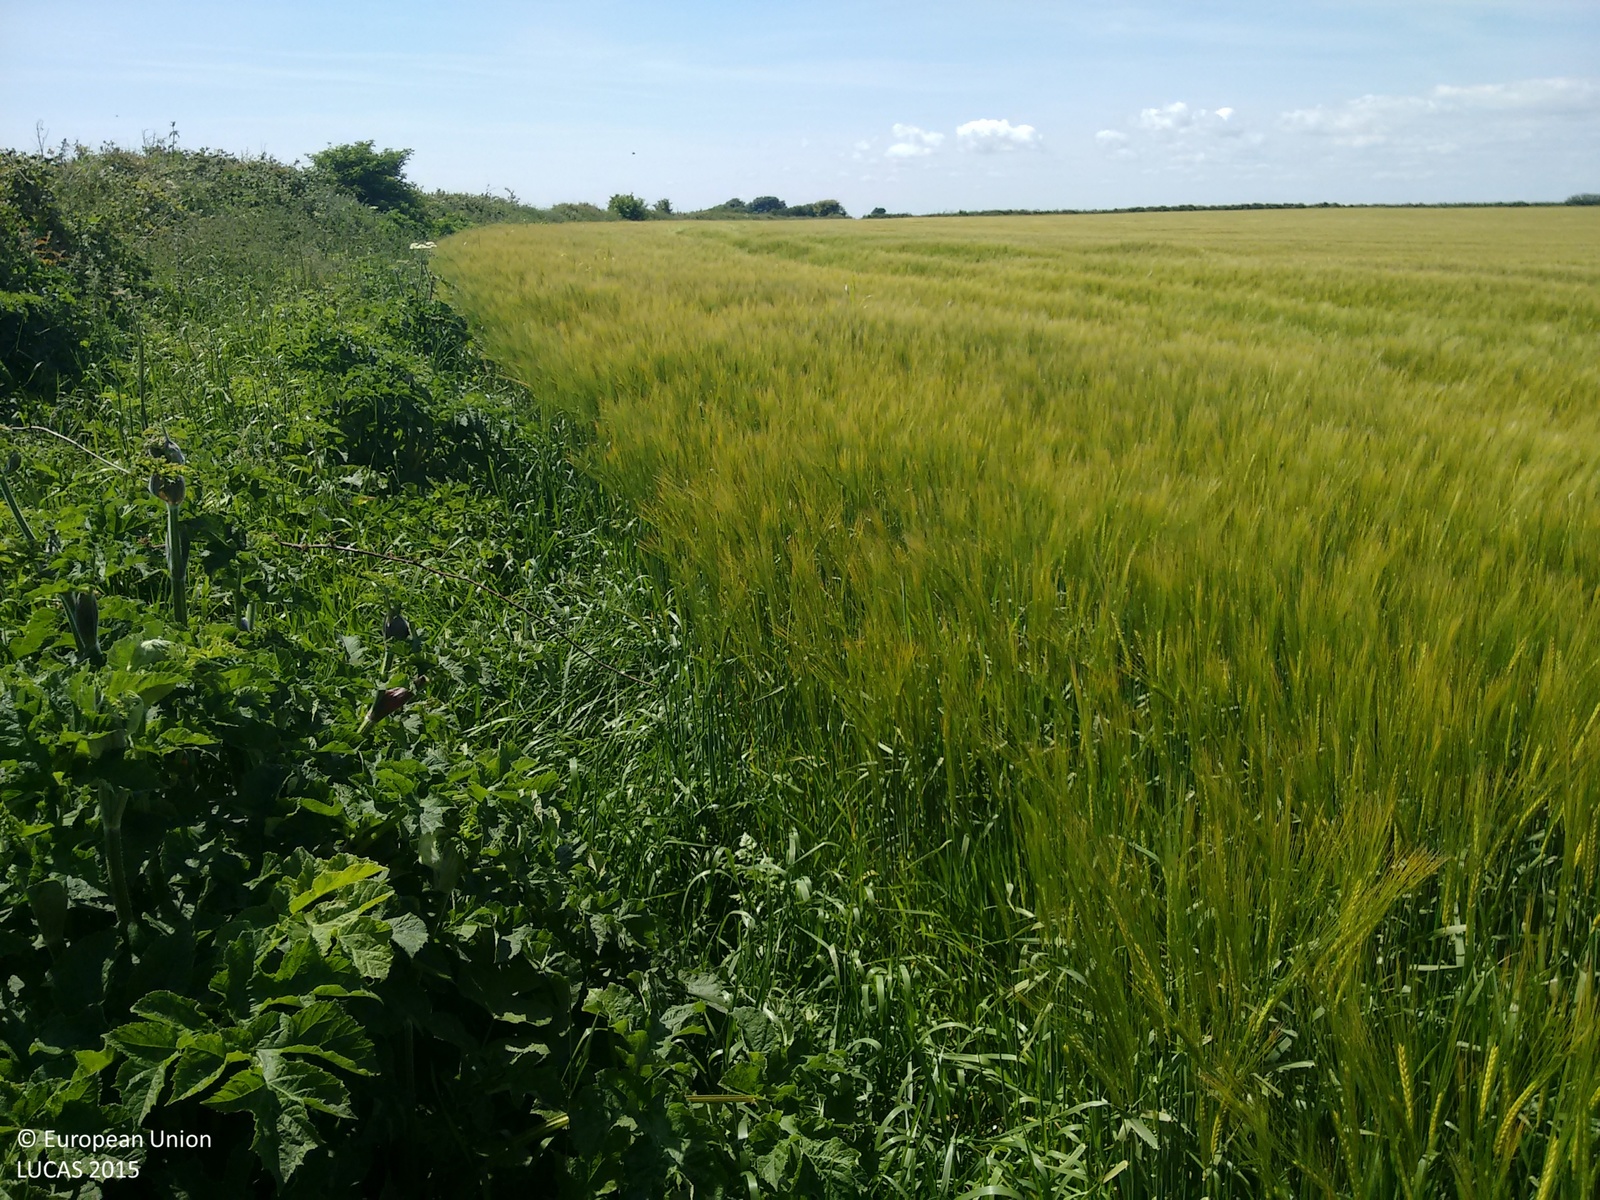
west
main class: Cropland
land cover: Common wheat
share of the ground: > 75 %
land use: Agriculture (excluding fallow land and kitchen gardens)
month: June
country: IE
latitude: 51.8790
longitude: -8.0605
